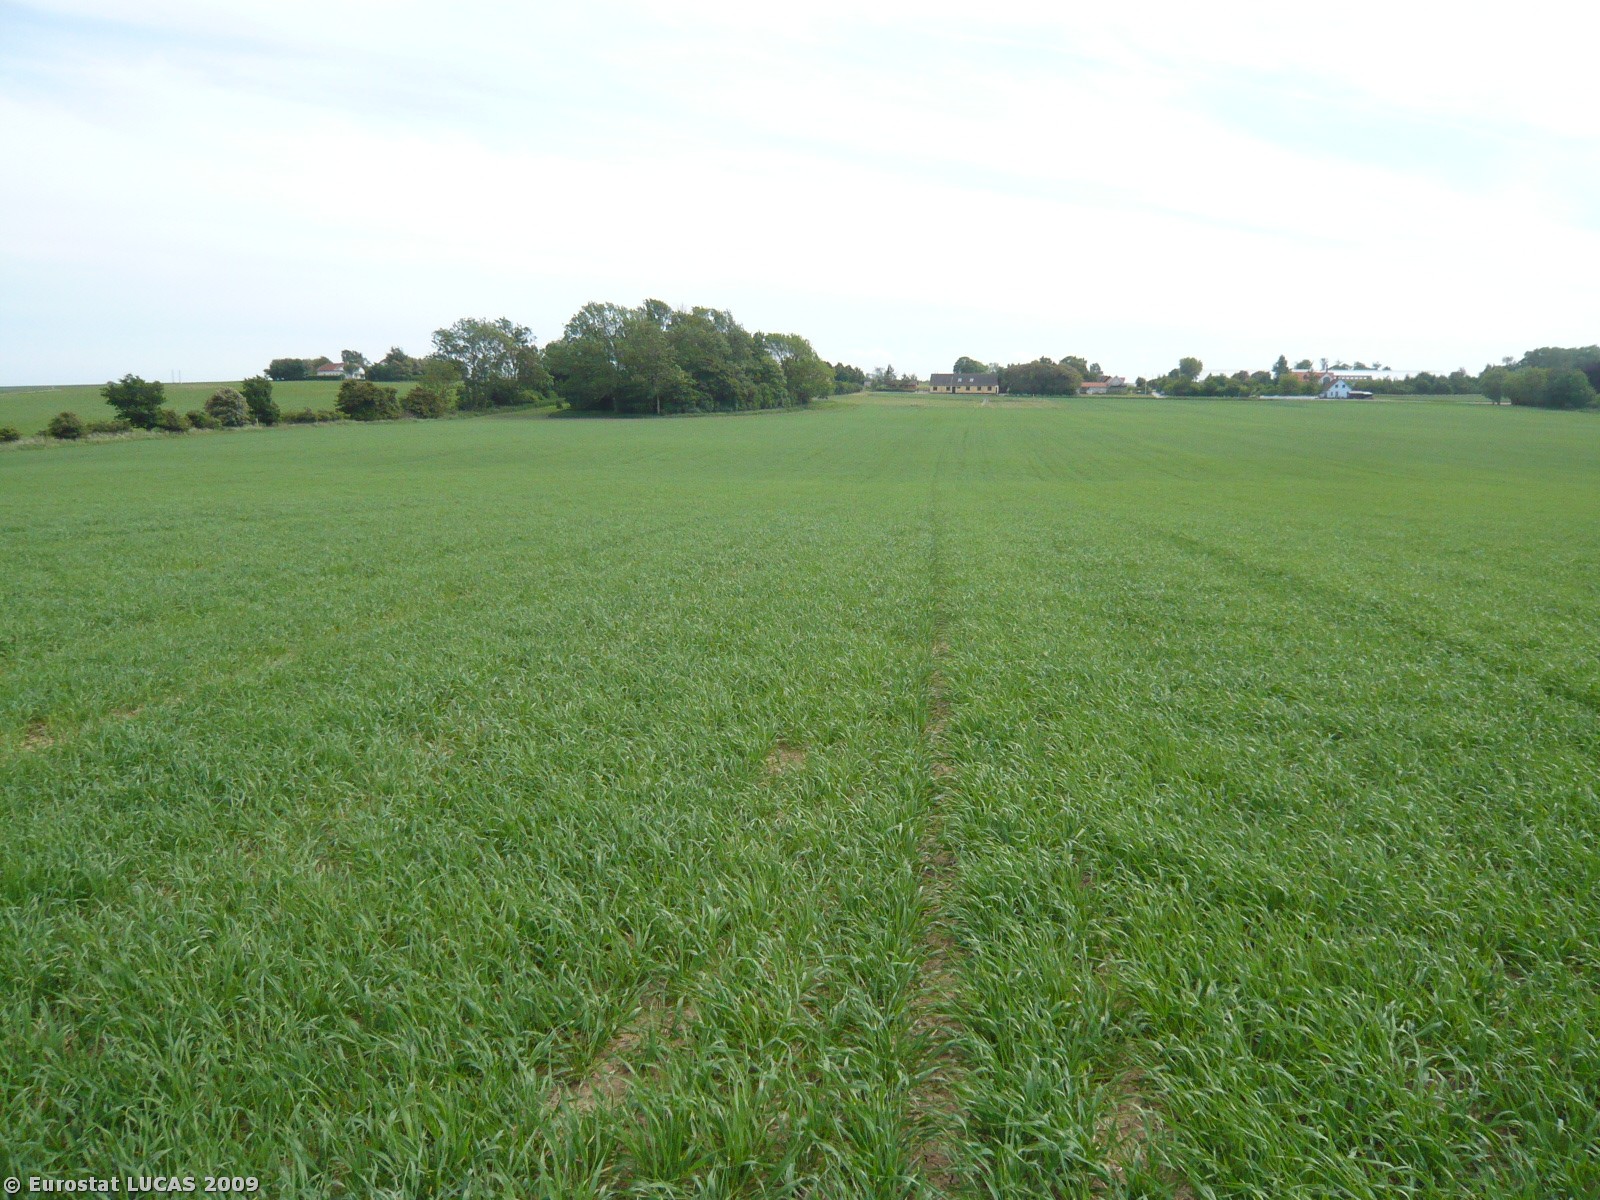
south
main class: Cropland
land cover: Barley
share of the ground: > 75 %
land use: Agriculture (excluding fallow land and kitchen gardens)
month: June
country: DK
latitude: 55.2287
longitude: 11.2725
